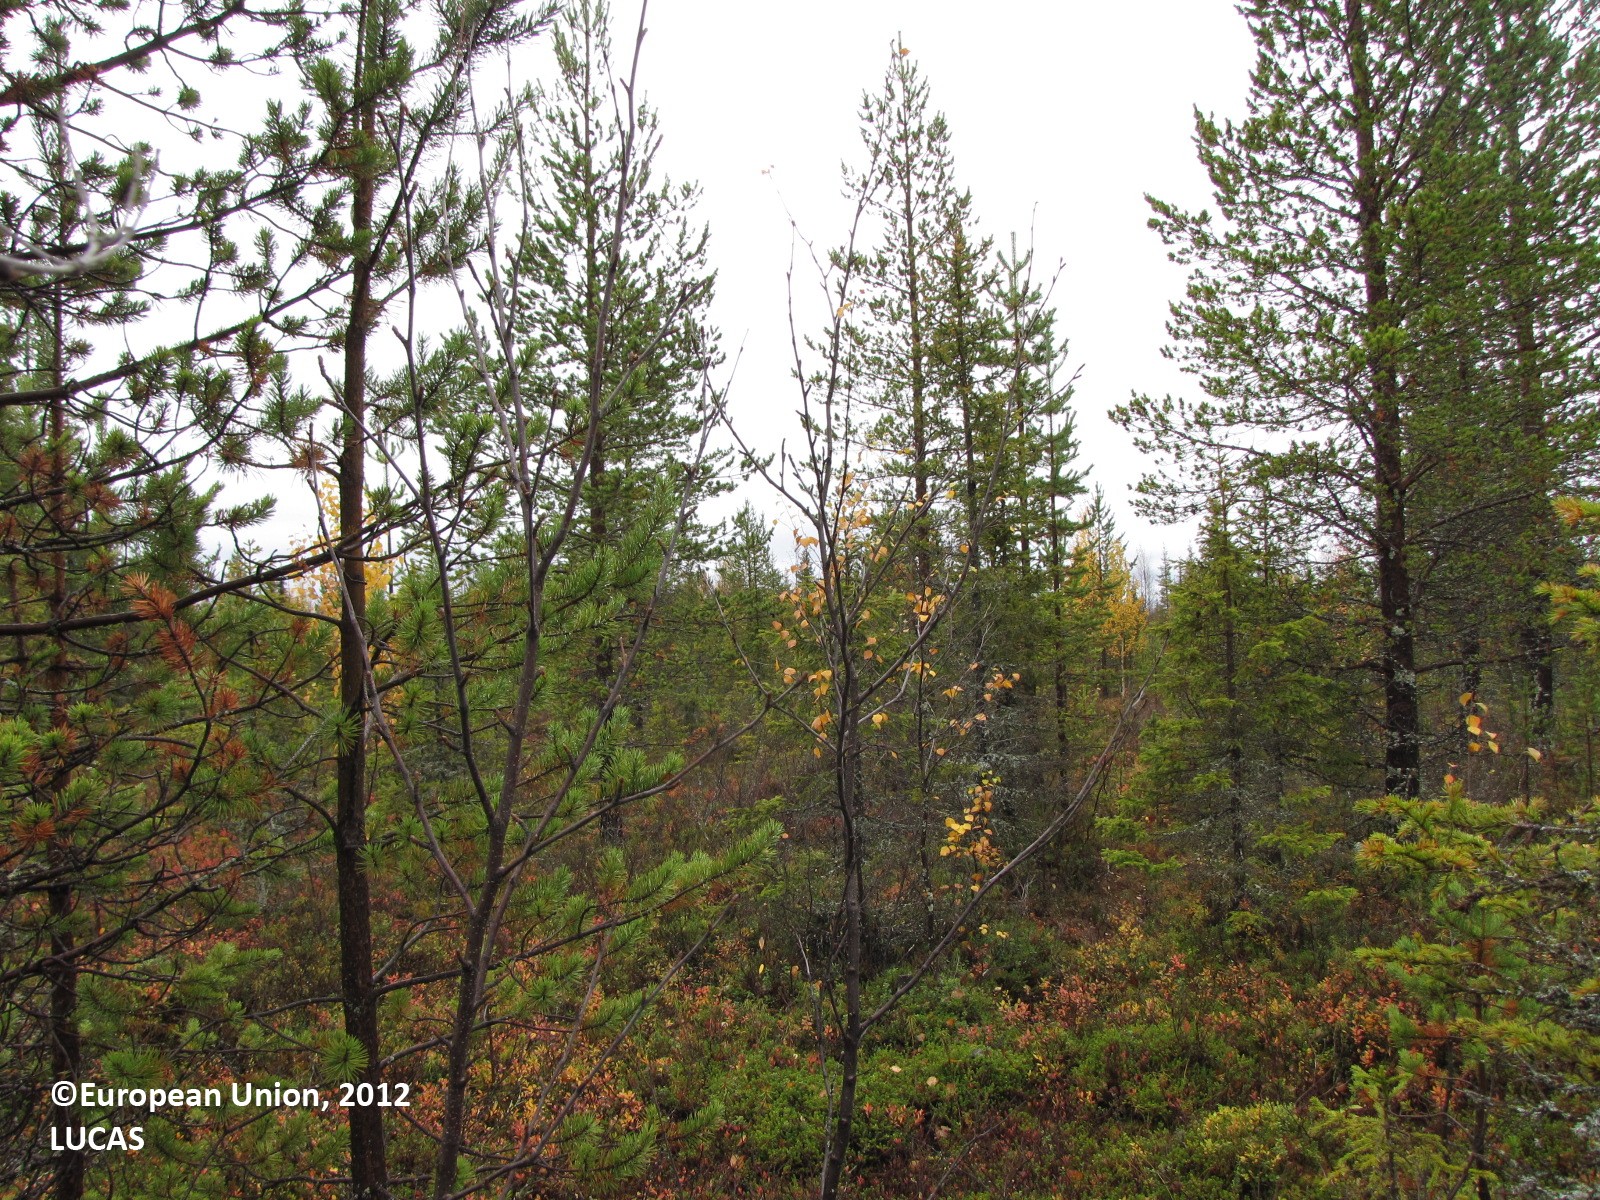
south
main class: Woodland
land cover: Other coniferous woodland
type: boreal forest
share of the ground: 25 - 50 %
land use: Forestry
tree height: > 5 m
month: September
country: FI
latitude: 67.4368
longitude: 25.3916
